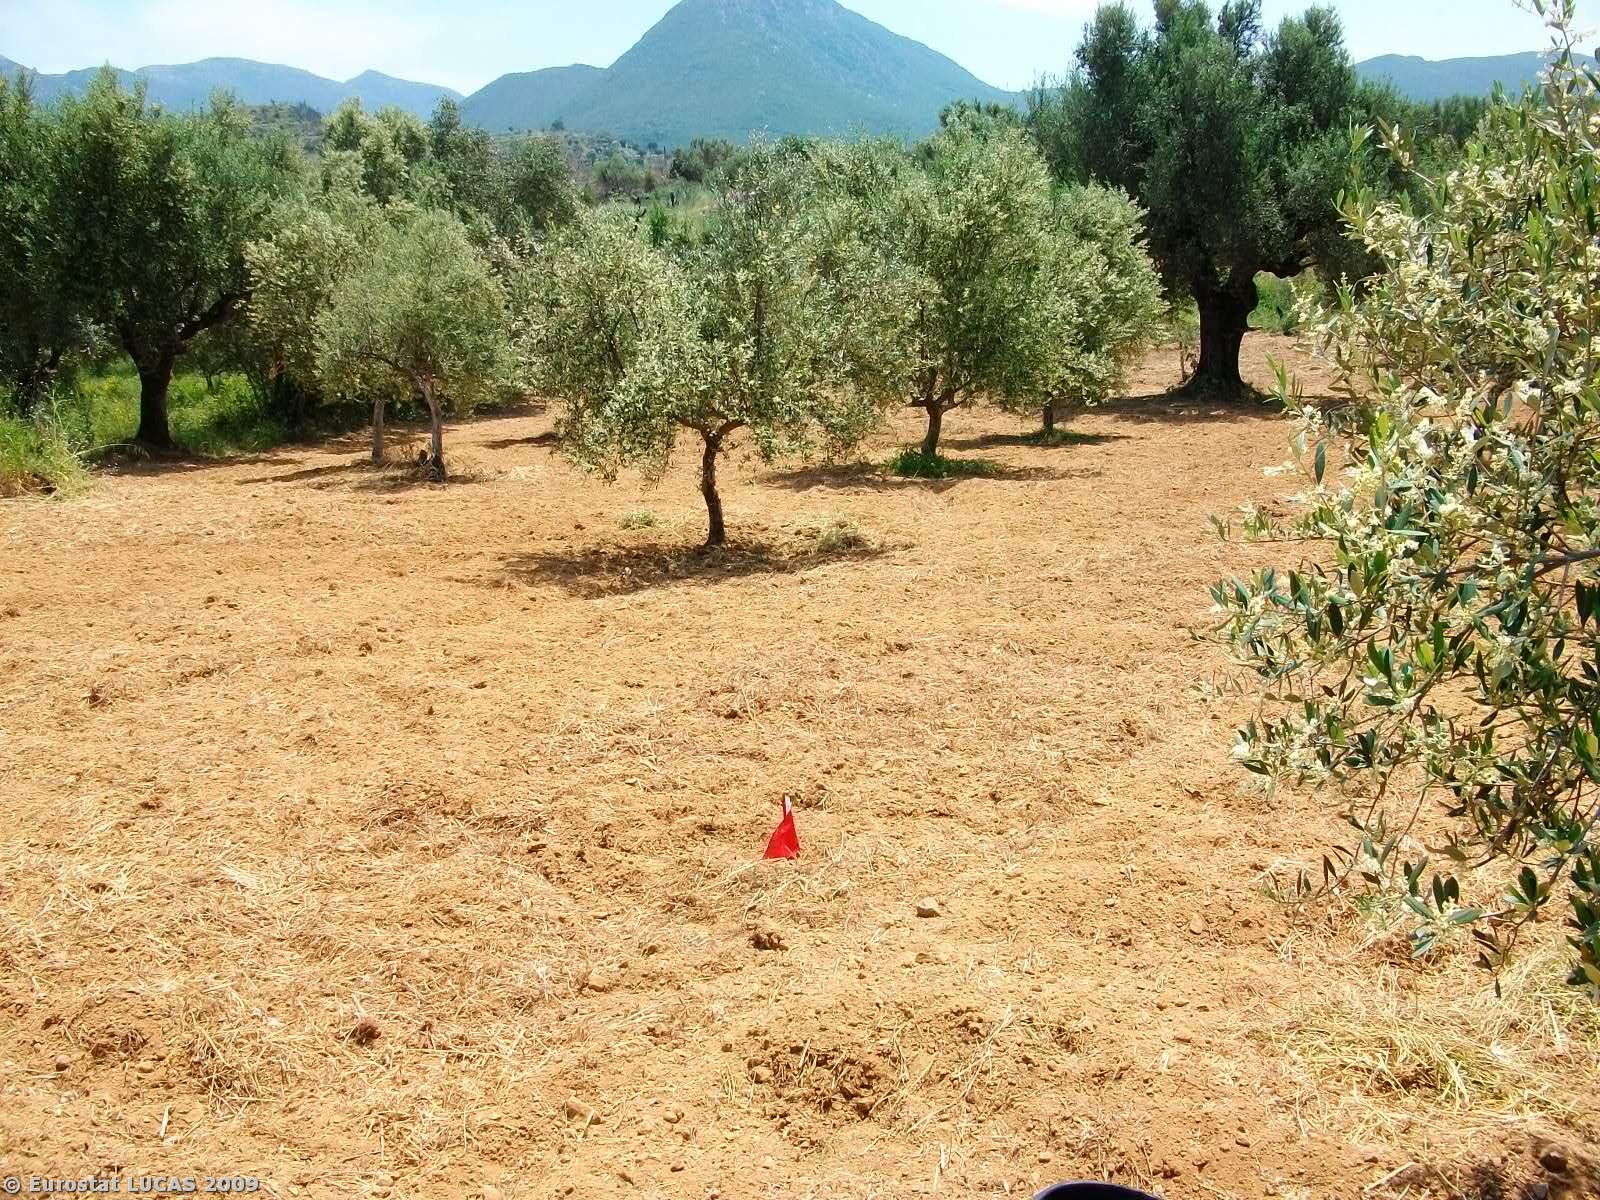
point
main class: Cropland
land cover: Olive groves
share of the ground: 25 - 50 %
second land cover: Bare land
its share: > 75 %
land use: Agriculture (excluding fallow land and kitchen gardens)
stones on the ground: < 10 %
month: May
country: GR
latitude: 37.2375
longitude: 22.0284
